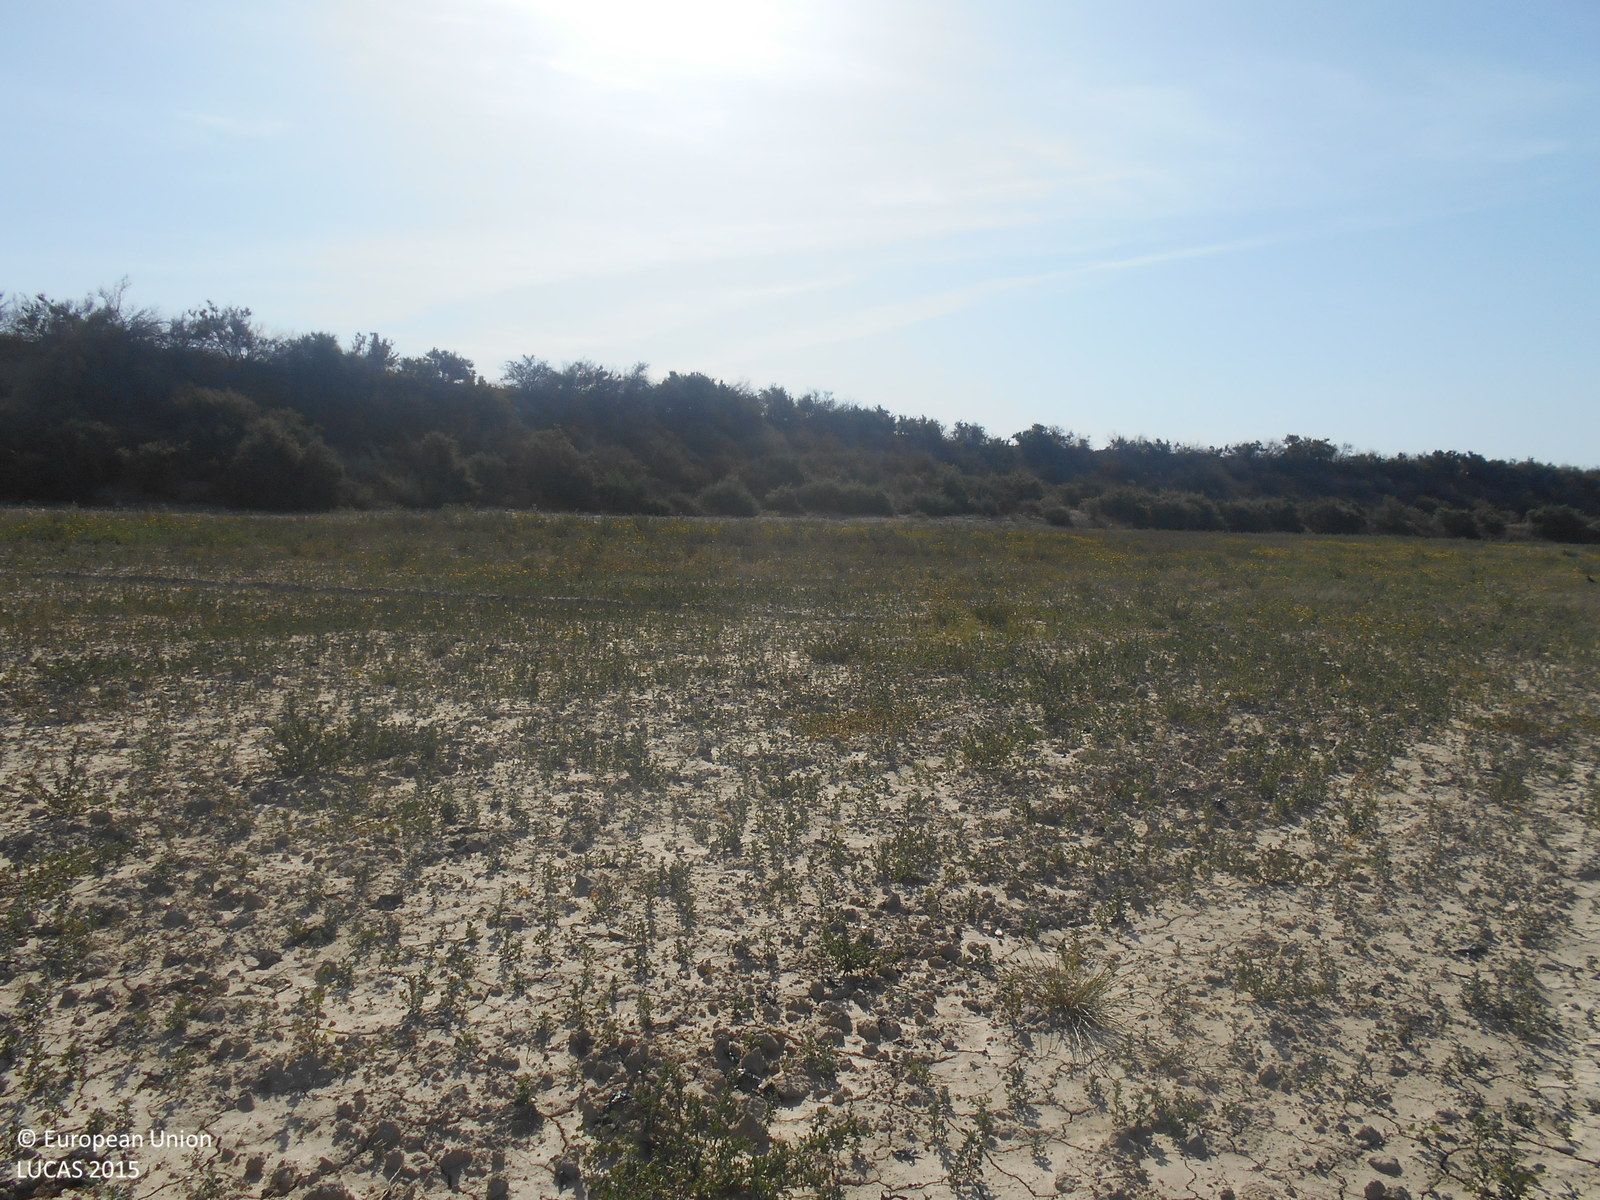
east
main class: Grassland
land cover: Spontaneously vegetated surfaces
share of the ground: 10 - 25 %
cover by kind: unconsolidated bare surface 80 %, herbaceous plants 20 %
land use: Fallow land
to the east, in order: Spontaneously vegetated surfaces; Shrubland without tree cover; Spontaneously vegetated surfaces; Shrubland without tree cover
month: May
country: ES
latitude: 37.6638
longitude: -1.3967
